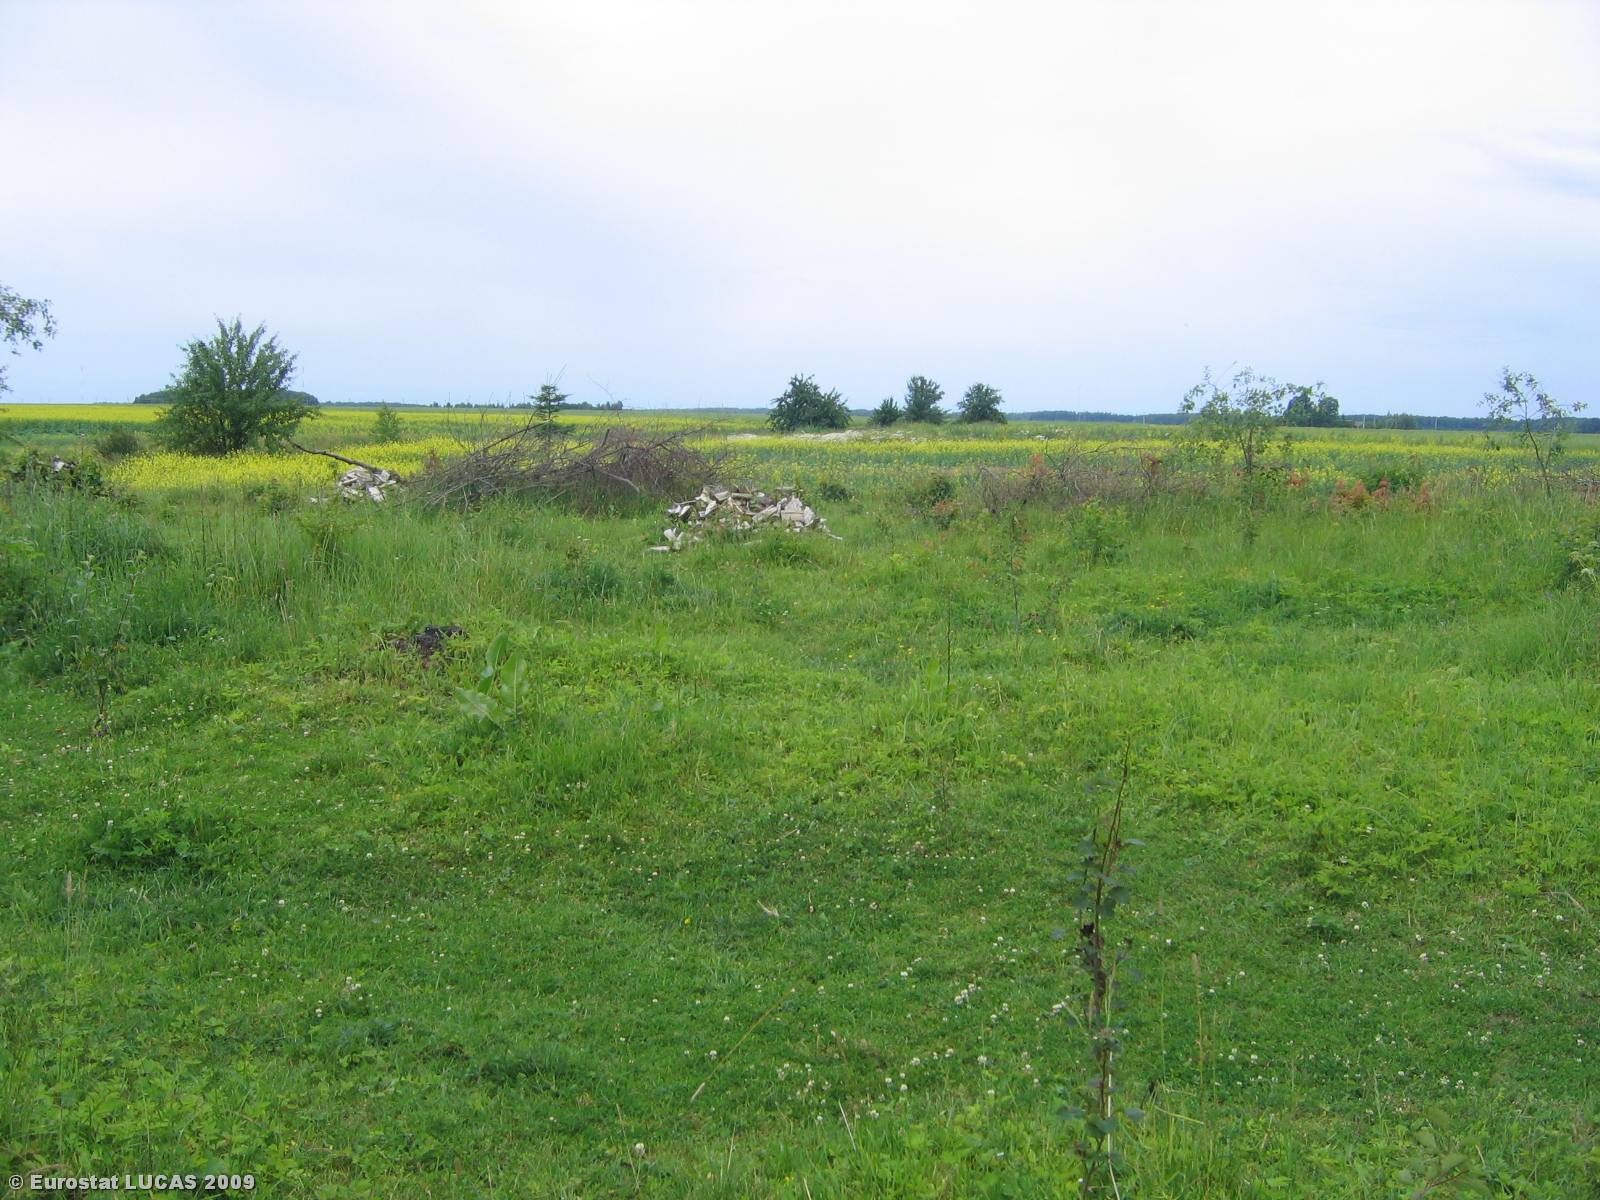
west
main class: Grassland
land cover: Grassland with sparse tree/shrub cover
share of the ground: > 75 %
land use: Residential
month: July
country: LT
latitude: 55.2763
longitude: 22.7376
